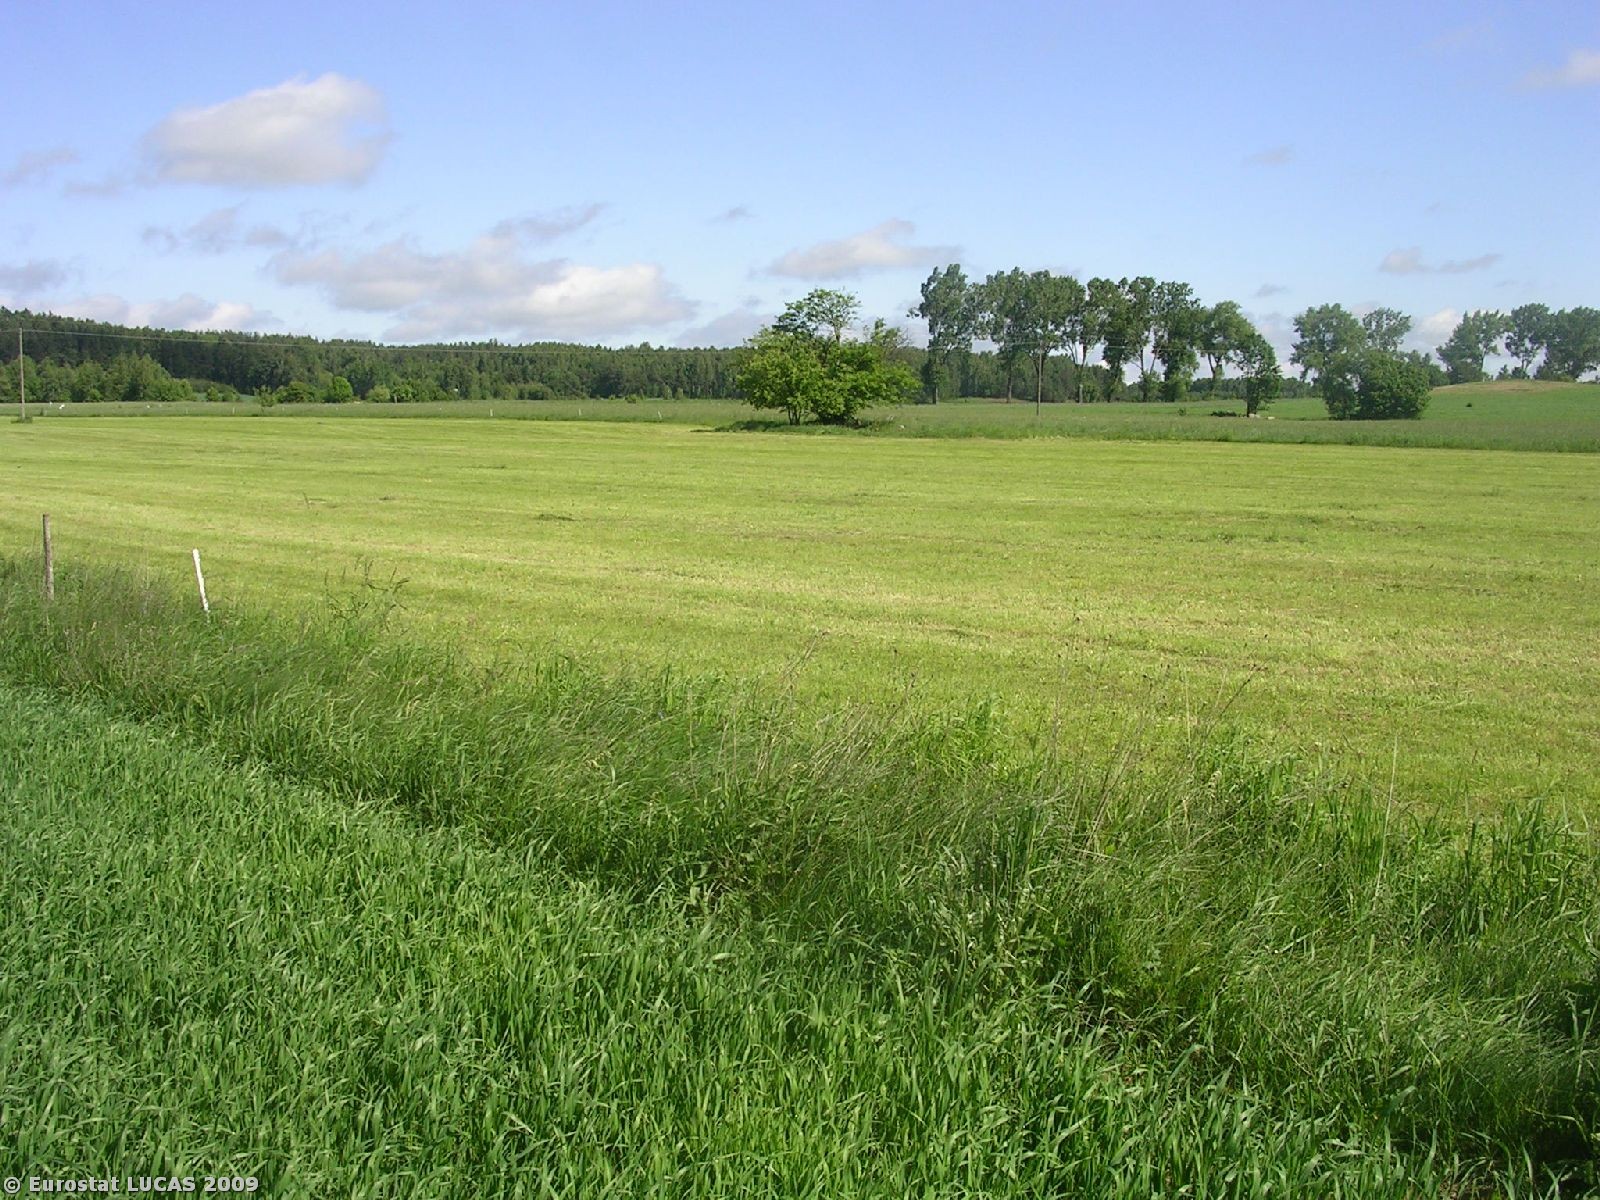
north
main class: Cropland
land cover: Oats
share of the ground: 25 - 50 %
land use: Agriculture (excluding fallow land and kitchen gardens)
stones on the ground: < 10 %
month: August
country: PL
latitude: 53.3856
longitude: 23.6942
